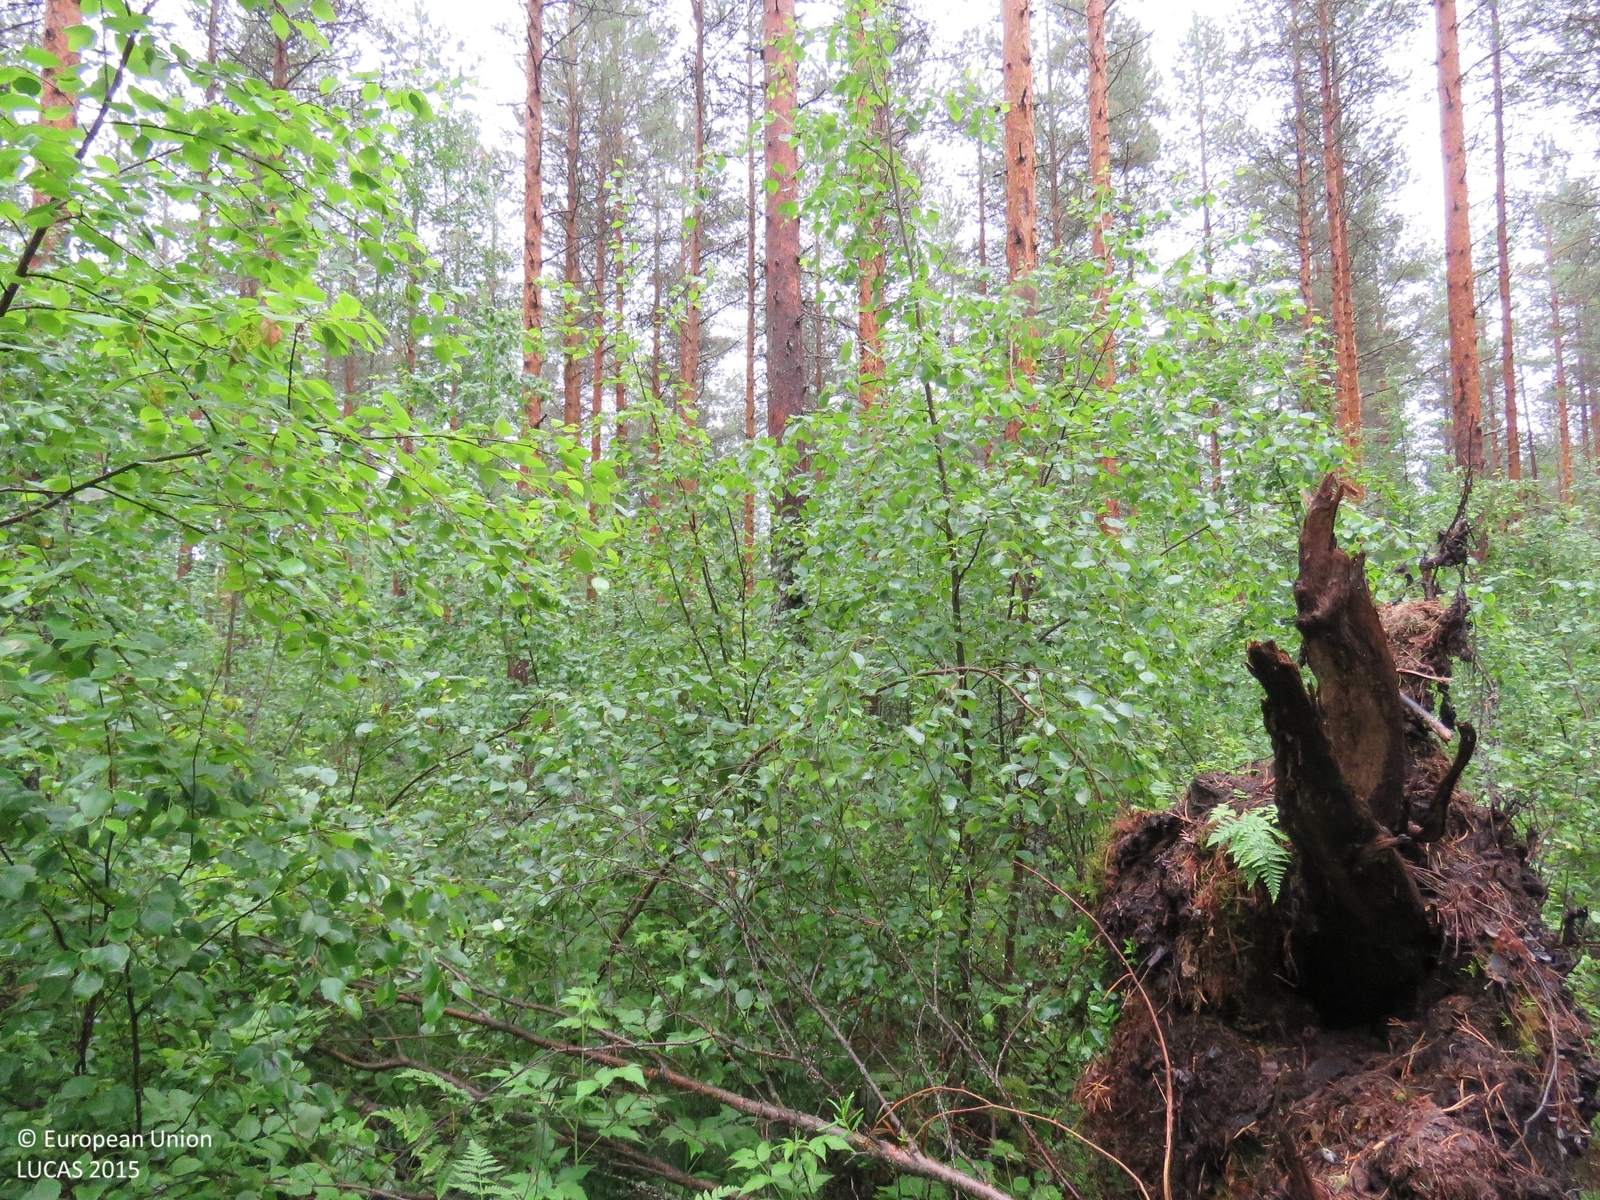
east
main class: Woodland
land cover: Pine dominated mixed woodland
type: boreal forest
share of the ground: > 75 %
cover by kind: coniferous forest trees 50 %, broadleaved forest trees 40 %, herbaceous plants 10 %
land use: Forestry
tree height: > 5 m
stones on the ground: < 10 %
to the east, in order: Pine dominated mixed woodland; Ditches and canals; Pine dominated mixed woodland; Ditches and canals; Pine dominated mixed woodland; Ditches and canals; Pine dominated mixed woodland; Ditches and canals; Pine dominated mixed woodland
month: July
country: FI
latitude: 64.3387
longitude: 26.8703
